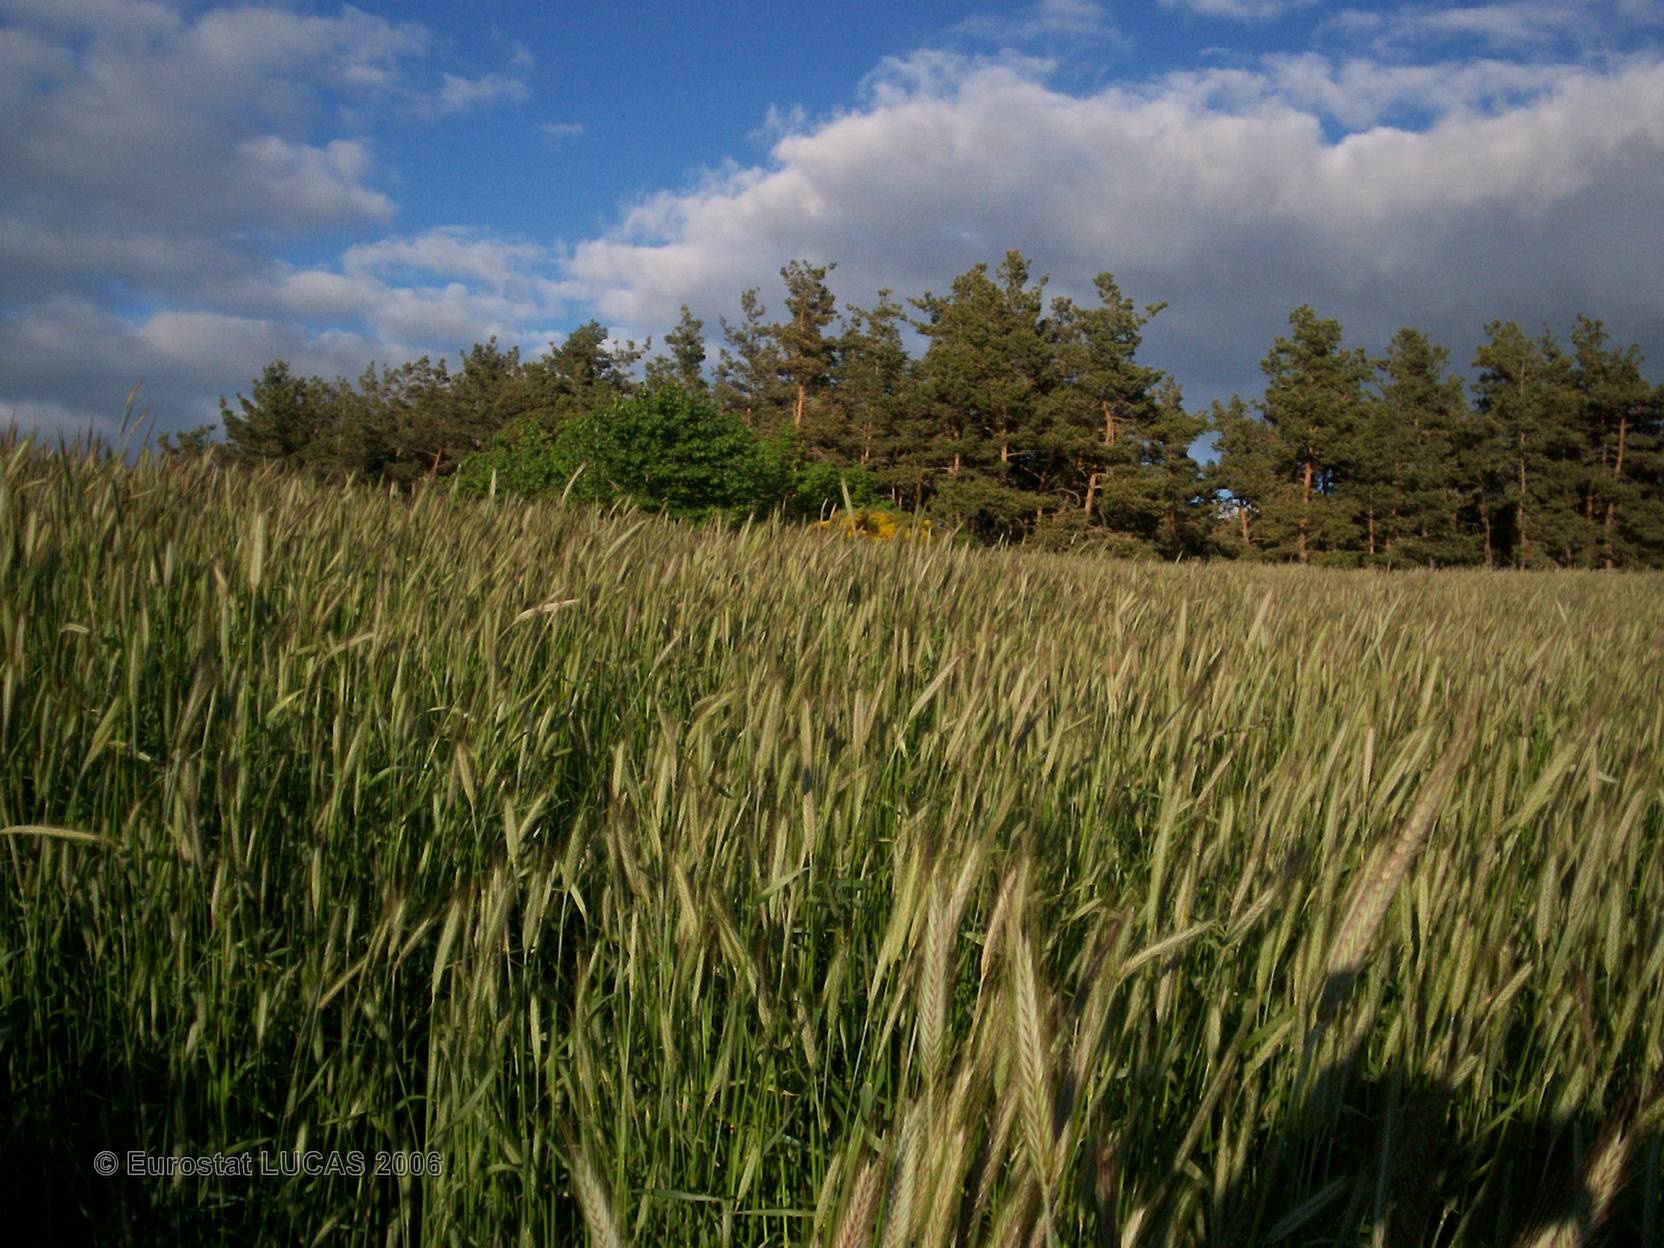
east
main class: Cropland
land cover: Common wheat
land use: Agriculture (excluding fallow land and kitchen gardens)
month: May
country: FR
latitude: 44.6623
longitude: 3.3578
